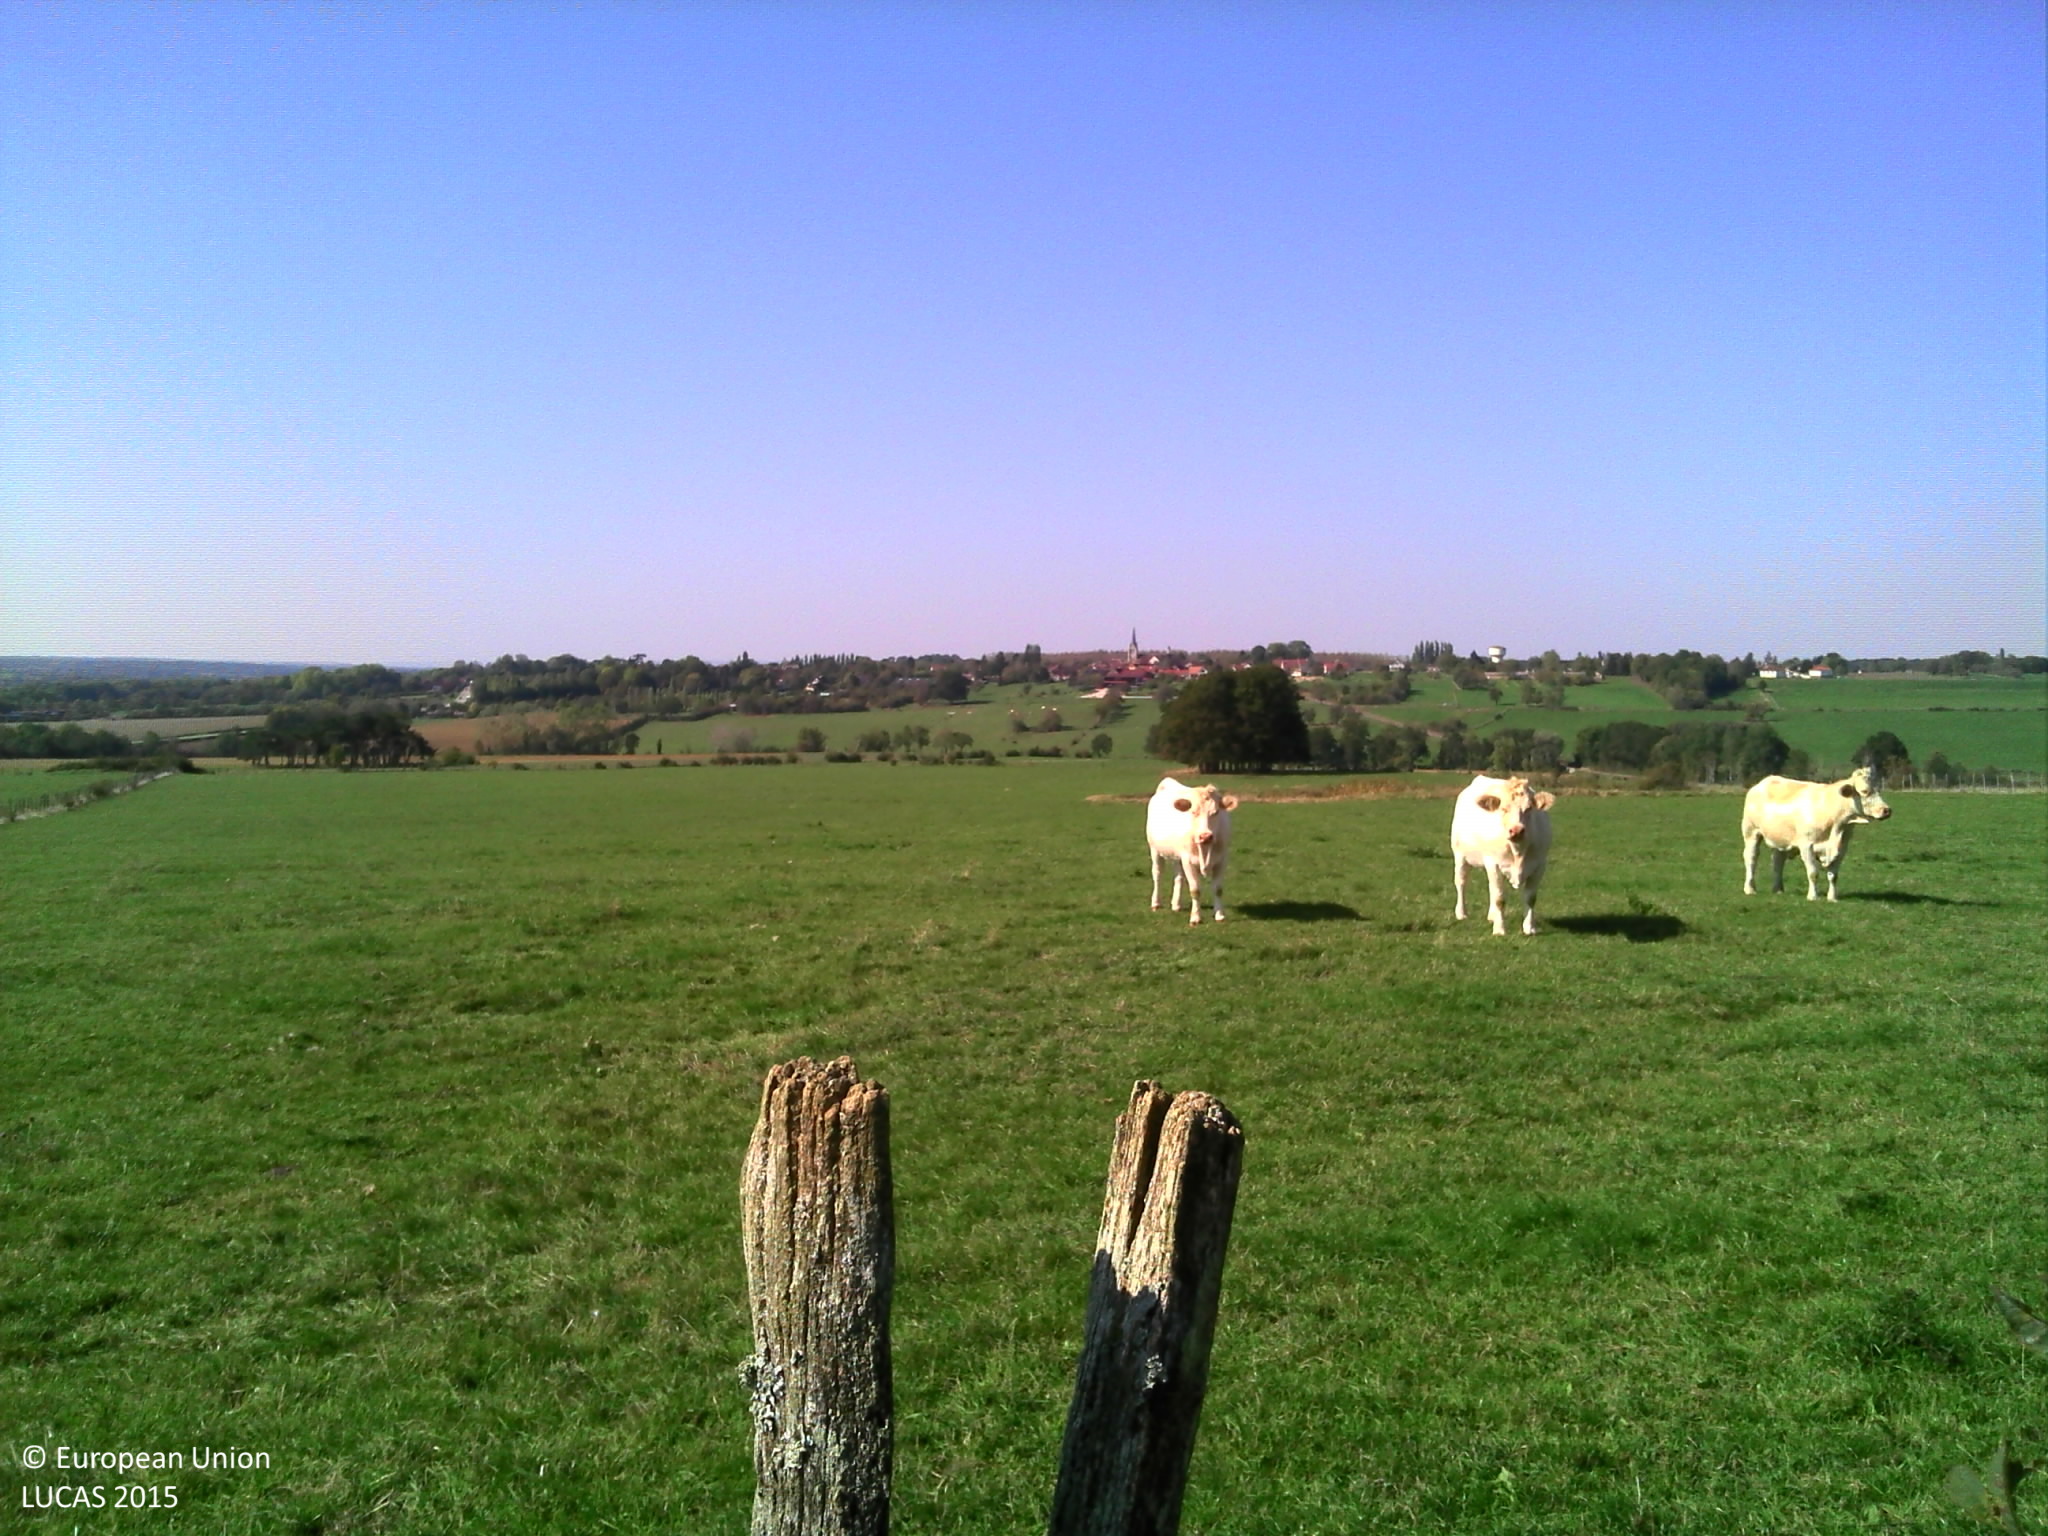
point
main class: Grassland
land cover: Grassland without tree/shrub cover
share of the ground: > 75 %
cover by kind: herbaceous plants 100 %
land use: Agriculture (excluding fallow land and kitchen gardens)
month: October
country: FR
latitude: 47.9466
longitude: 3.9046
